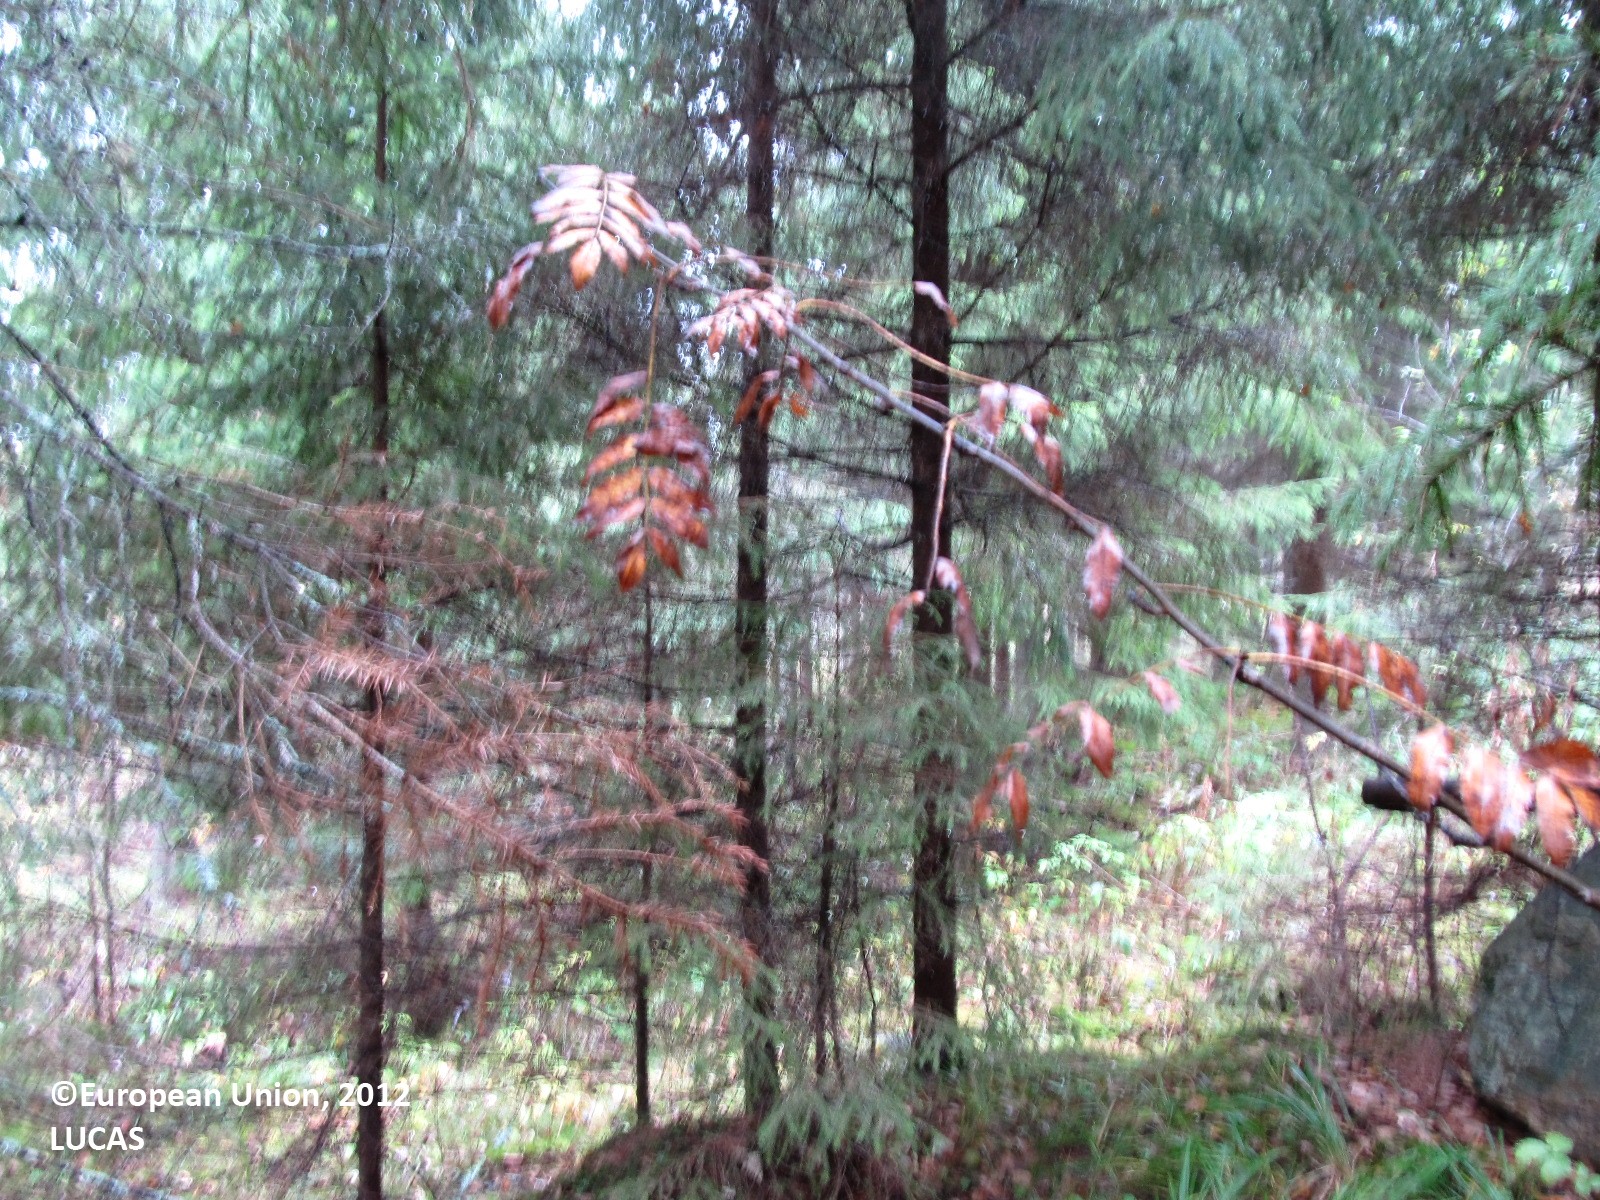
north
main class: Woodland
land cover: Spruce dominated coniferous woodland
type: boreal forest
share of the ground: 50 - 75 %
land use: Forestry
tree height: > 5 m
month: September
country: FI
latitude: 62.5739
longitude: 27.9890
